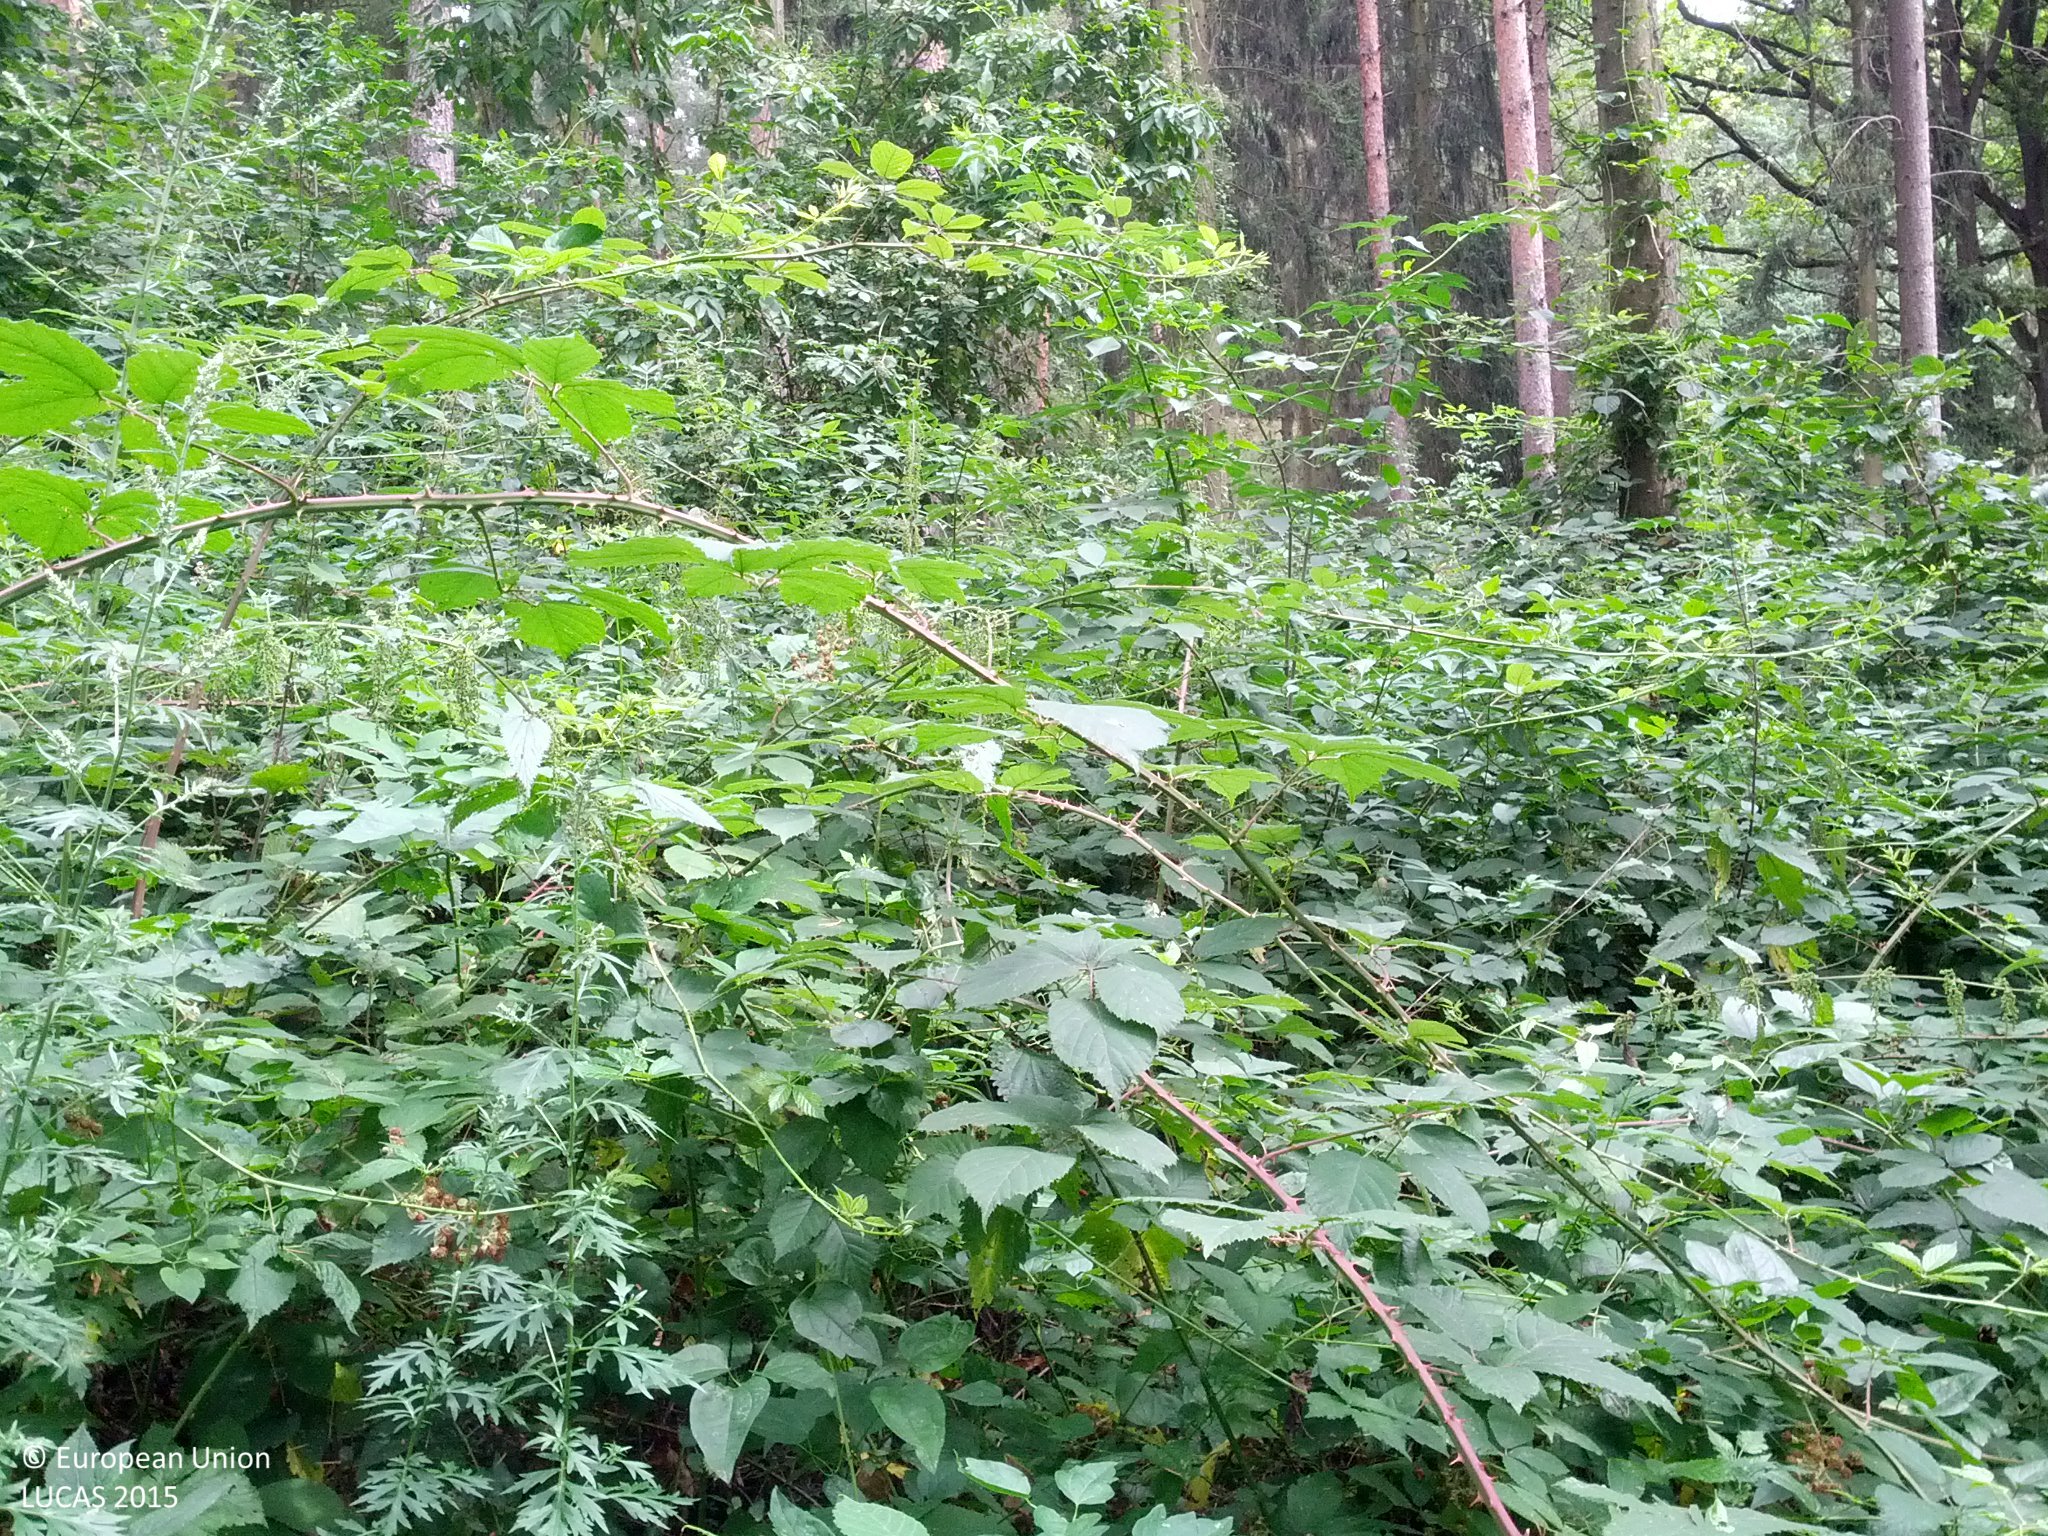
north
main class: Woodland
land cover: Pine dominated coniferous woodland
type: hemiboreal forest and nemoral coniferous forest and mixed broadleaved-coniferous forest
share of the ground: 50 - 75 %
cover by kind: coniferous forest trees 70 %, shrubs 20 %, herbaceous plants 10 %
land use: Forestry
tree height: > 5 m
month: July
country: AT
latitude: 48.5232
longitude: 16.1111
